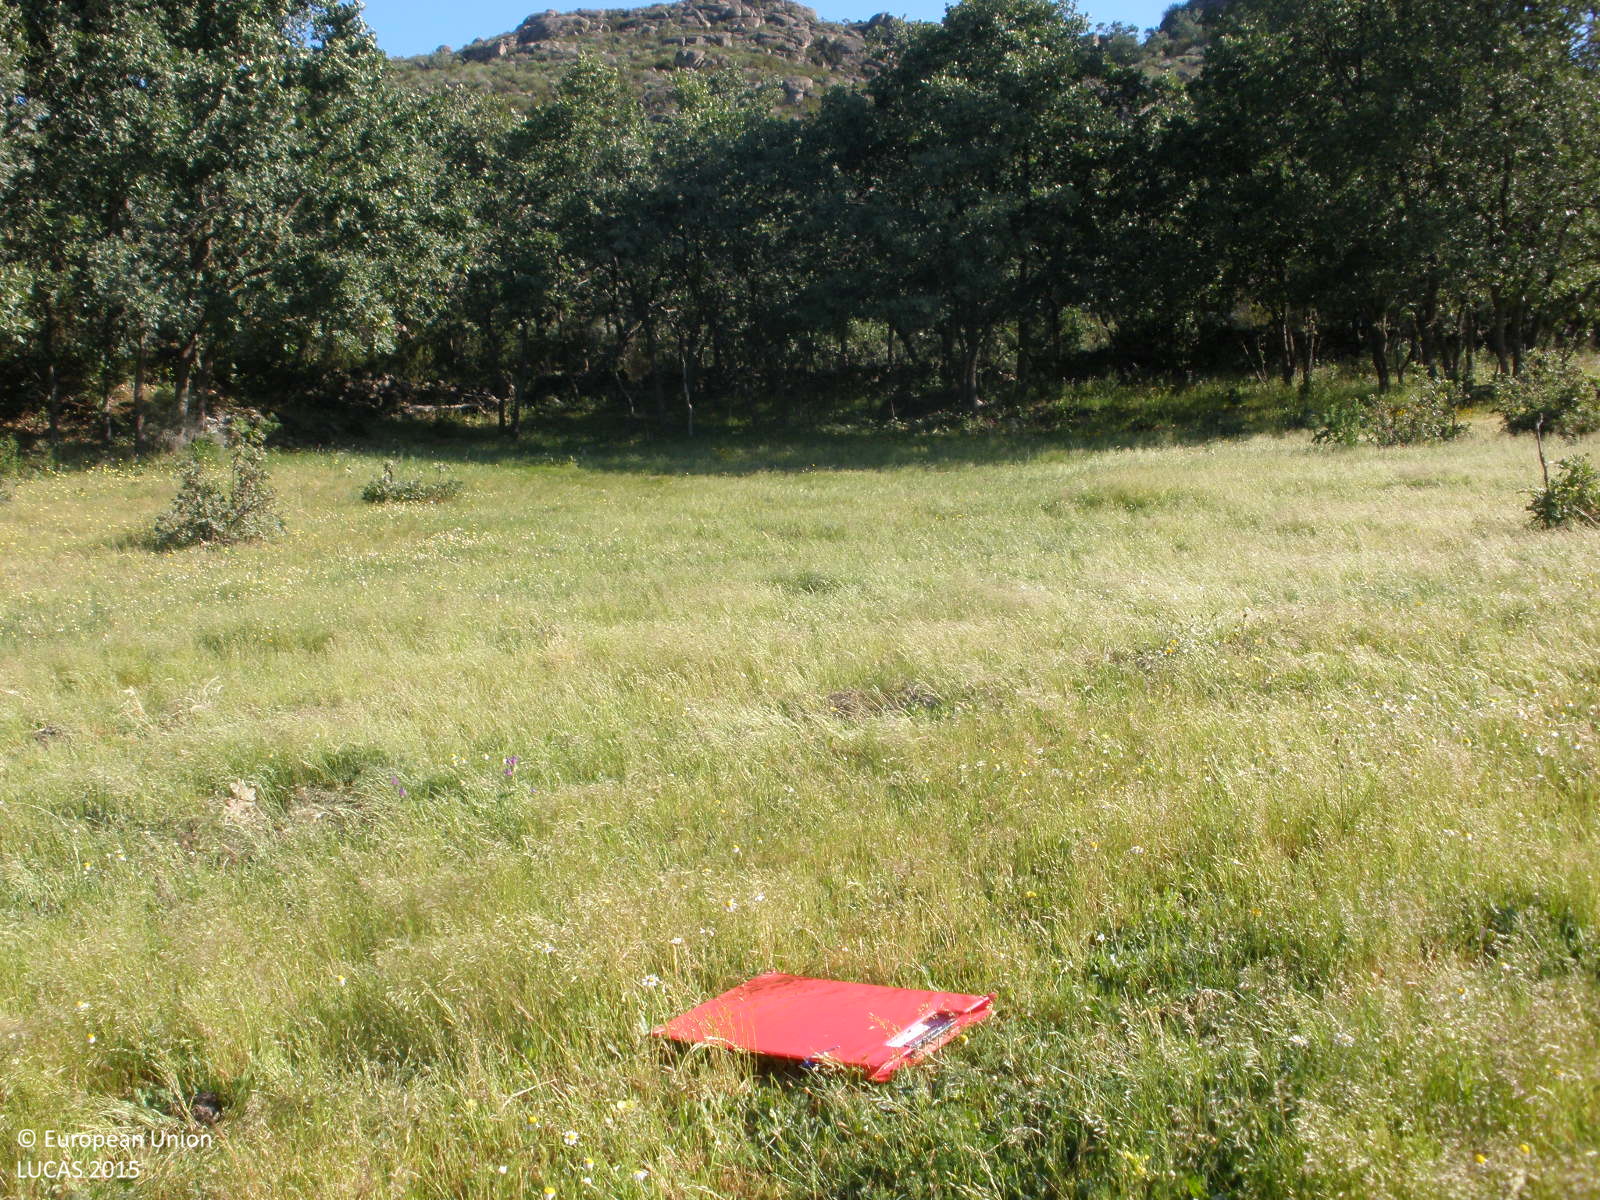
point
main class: Grassland
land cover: Grassland without tree/shrub cover
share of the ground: > 75 %
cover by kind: herbaceous plants 95 %, shrubs 5 %
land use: Agriculture (excluding fallow land and kitchen gardens)
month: May
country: ES
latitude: 40.1630
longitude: -6.8444
